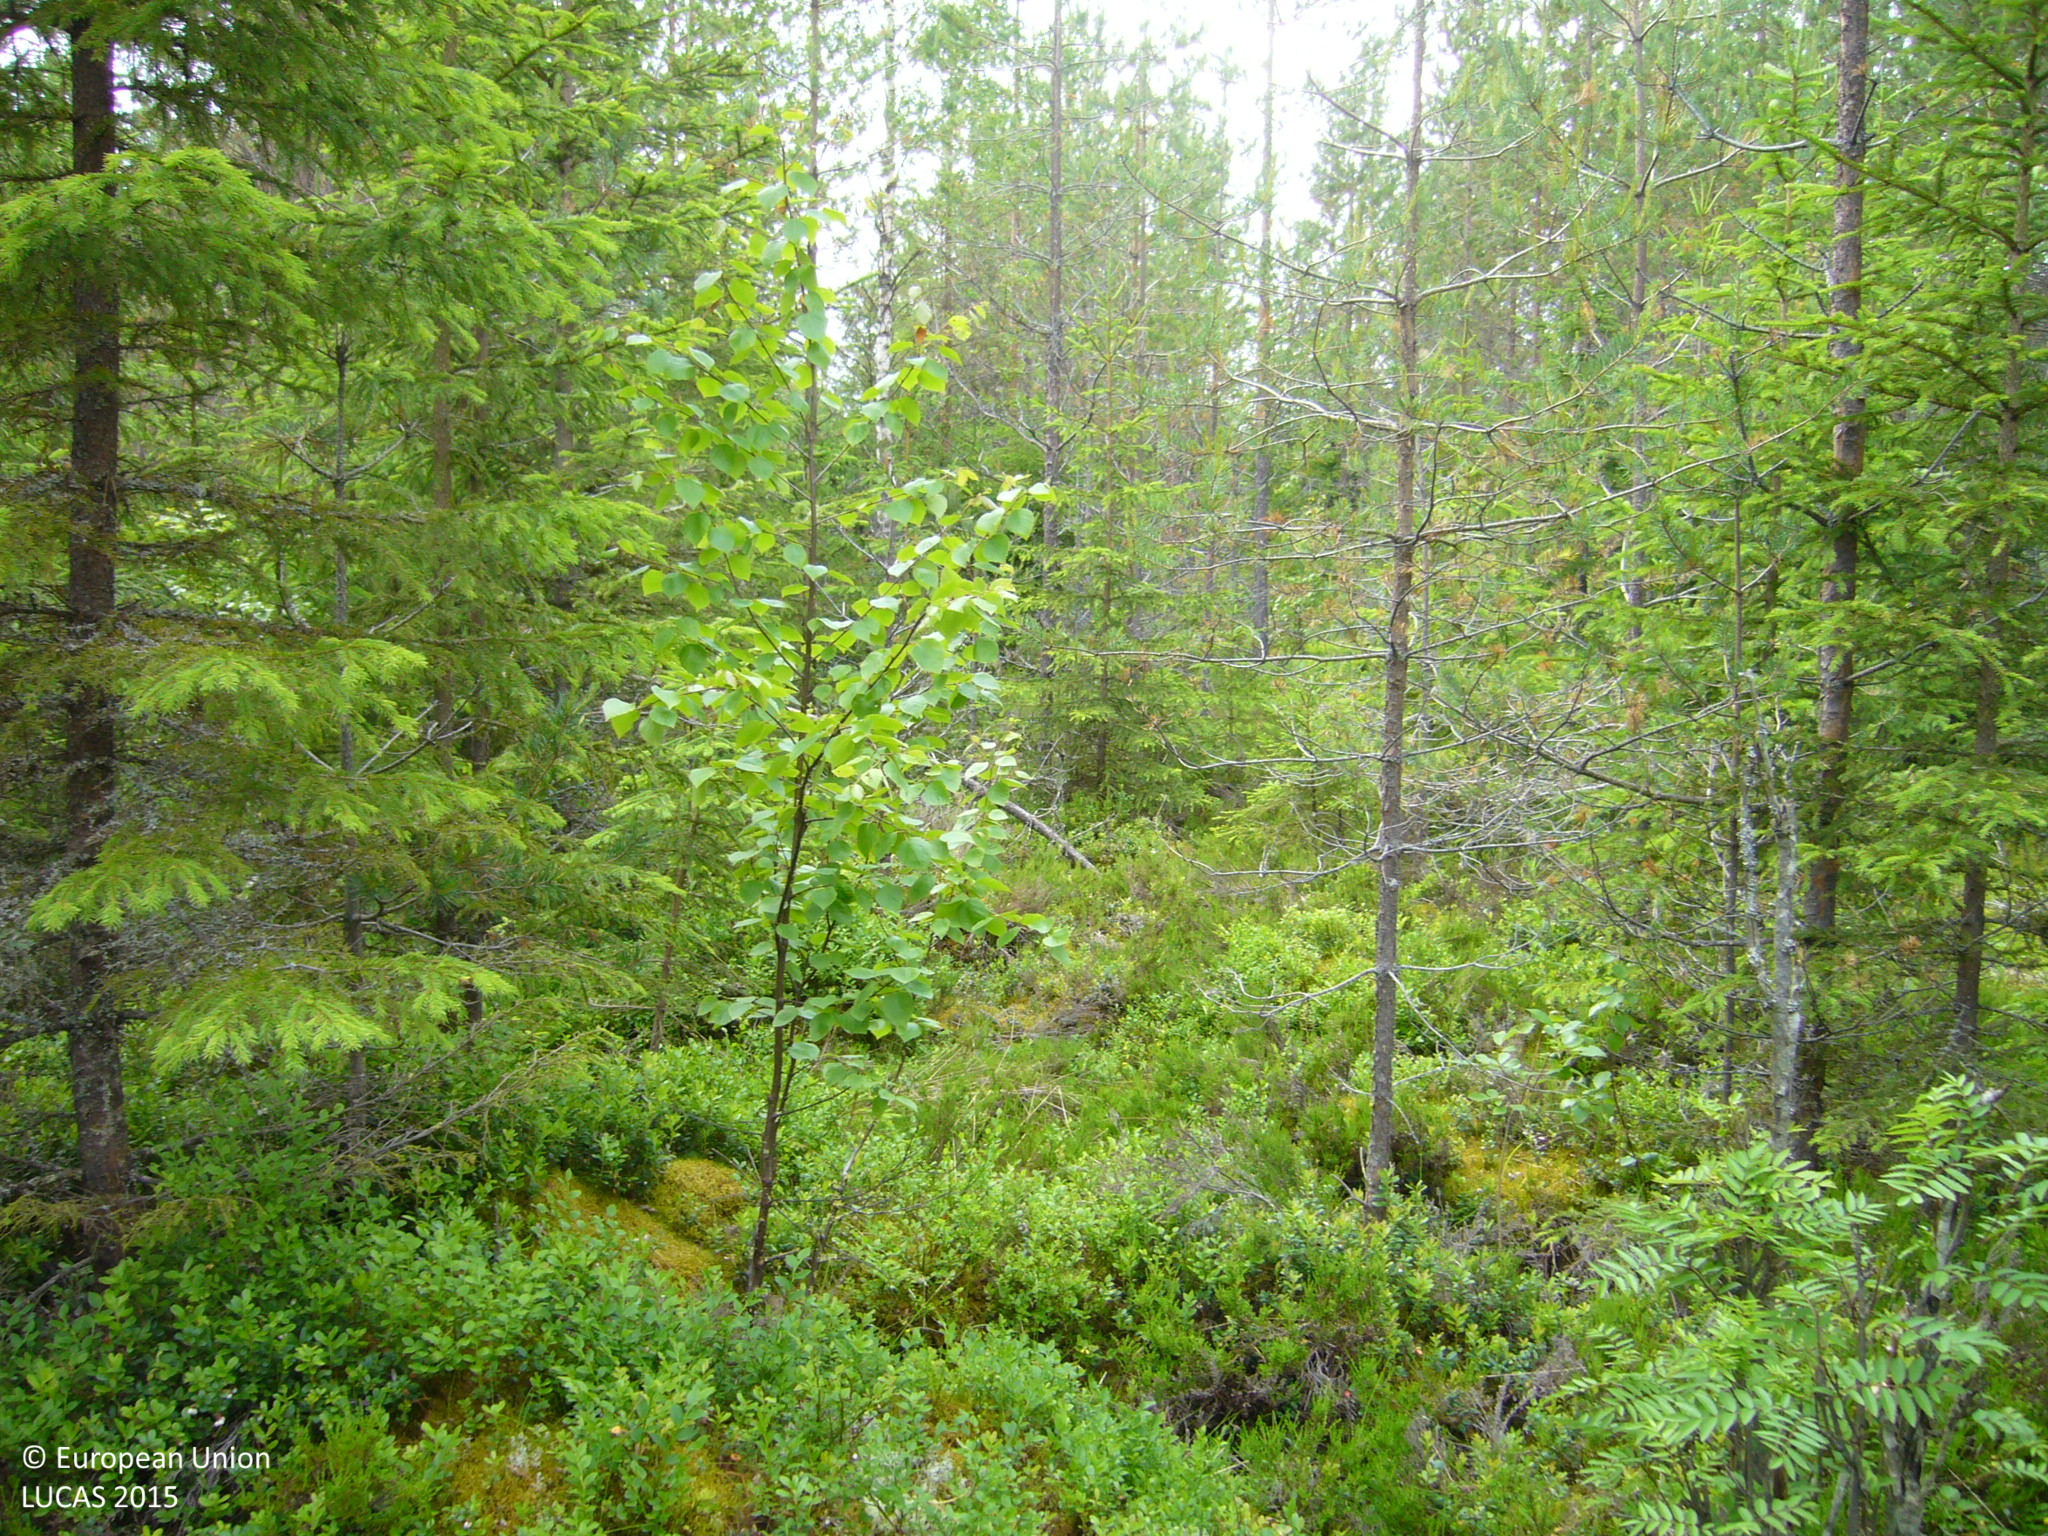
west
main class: Woodland
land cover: Pine dominated coniferous woodland
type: boreal forest
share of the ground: 50 - 75 %
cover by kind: coniferous forest trees 60 %, shrubs 40 %
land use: Forestry
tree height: > 5 m
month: July
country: FI
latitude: 63.5616
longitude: 25.6248
